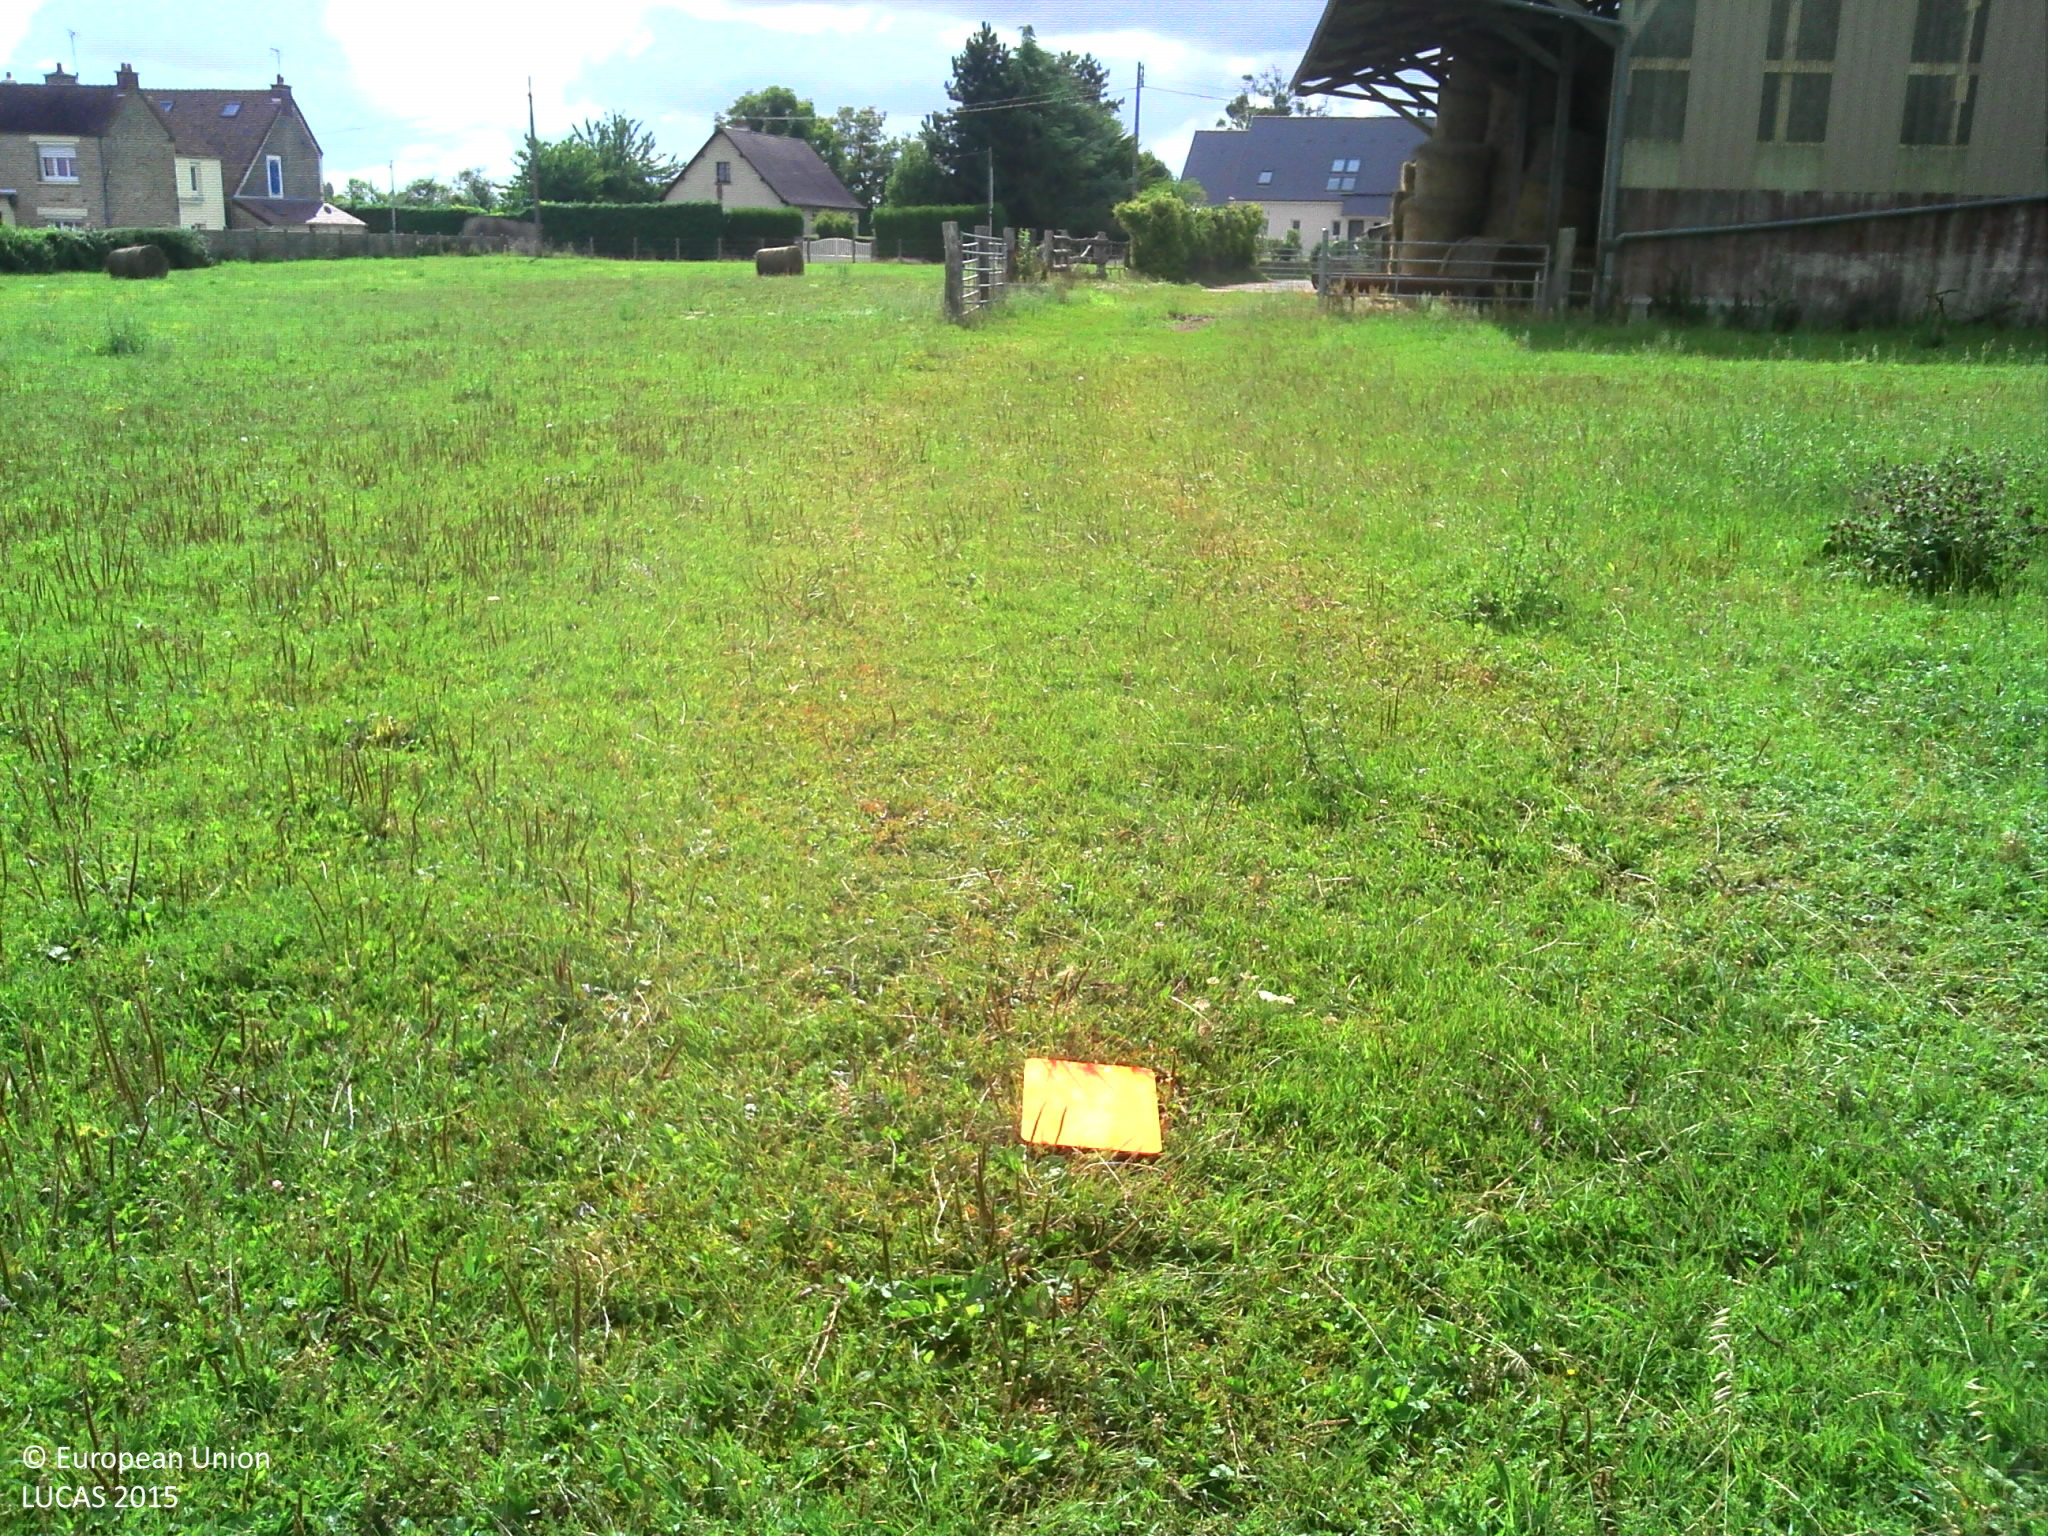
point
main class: Grassland
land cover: Grassland without tree/shrub cover
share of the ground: > 75 %
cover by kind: herbaceous plants 100 %
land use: Agriculture (excluding fallow land and kitchen gardens)
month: July
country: FR
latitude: 48.8769
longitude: -0.1631
